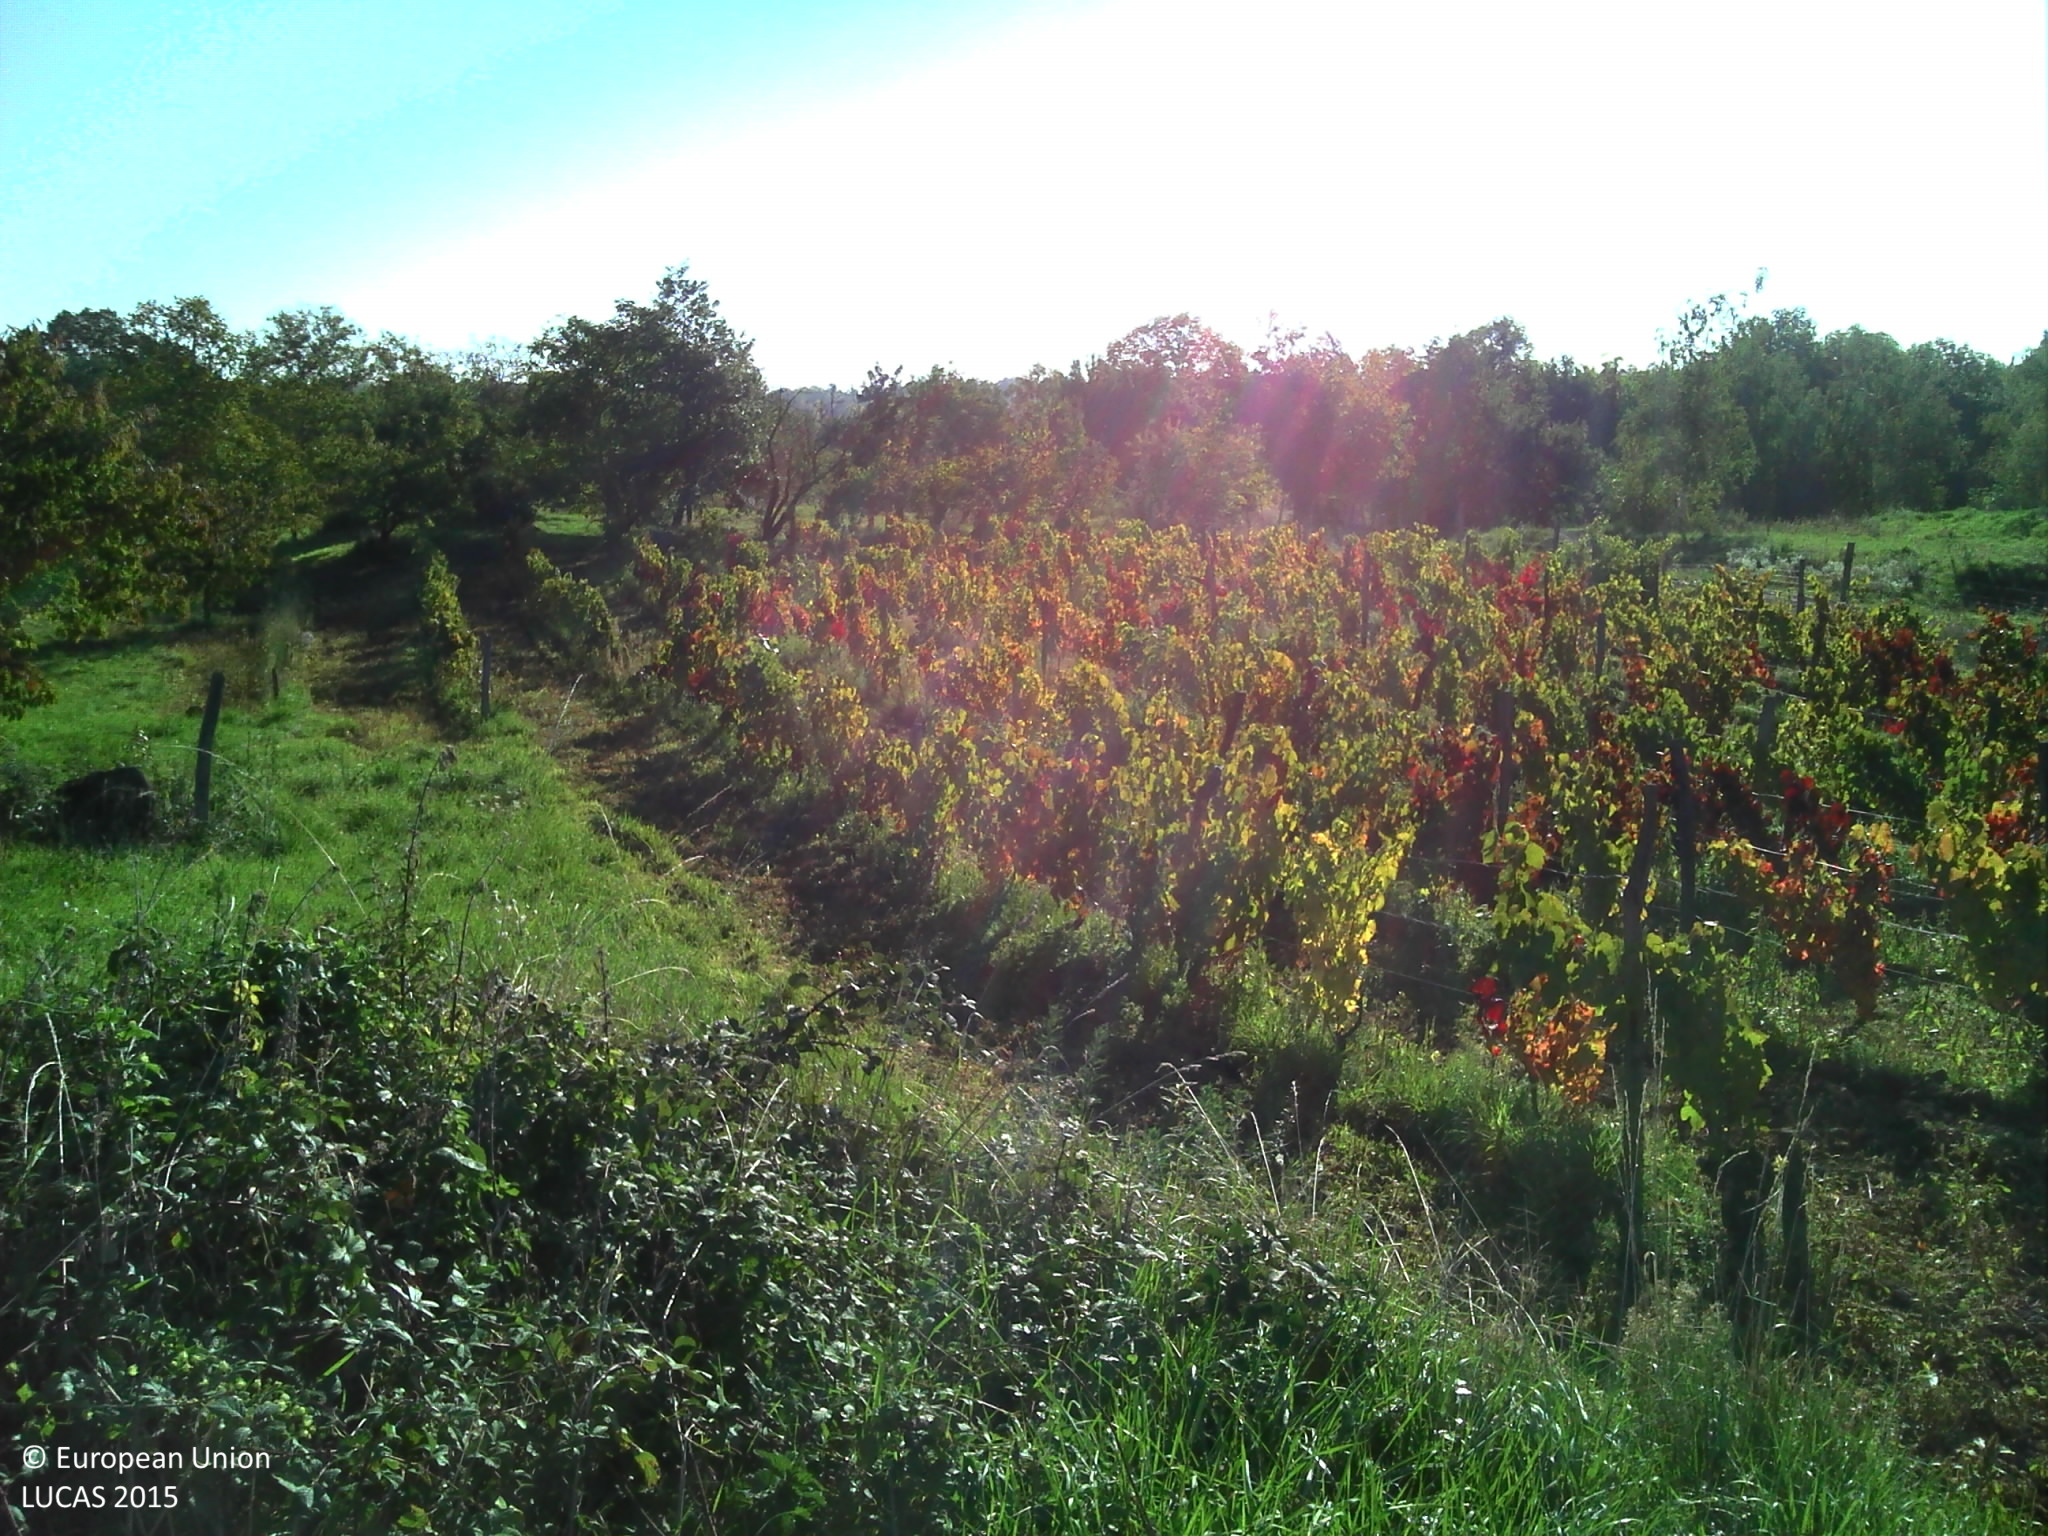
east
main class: Grassland
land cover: Grassland with sparse tree/shrub cover
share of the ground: > 75 %
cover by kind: herbaceous plants 95 %, broadleaved forest trees 5 %
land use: Agriculture (excluding fallow land and kitchen gardens)
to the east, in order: Grassland with sparse tree/shrub cover; Vineyards; Cherry fruit; Apple fruit; Grassland without tree/shrub cover; Nuts trees; Grass margins; Tracks; Grass margins; Abandoned hedges; Spontaneously vegetated surfaces; Lines of trees; Grass margins; Tracks; Grass margins; Nuts trees; Grassland without tree/shrub cover
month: September
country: FR
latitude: 45.8364
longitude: 3.0600
